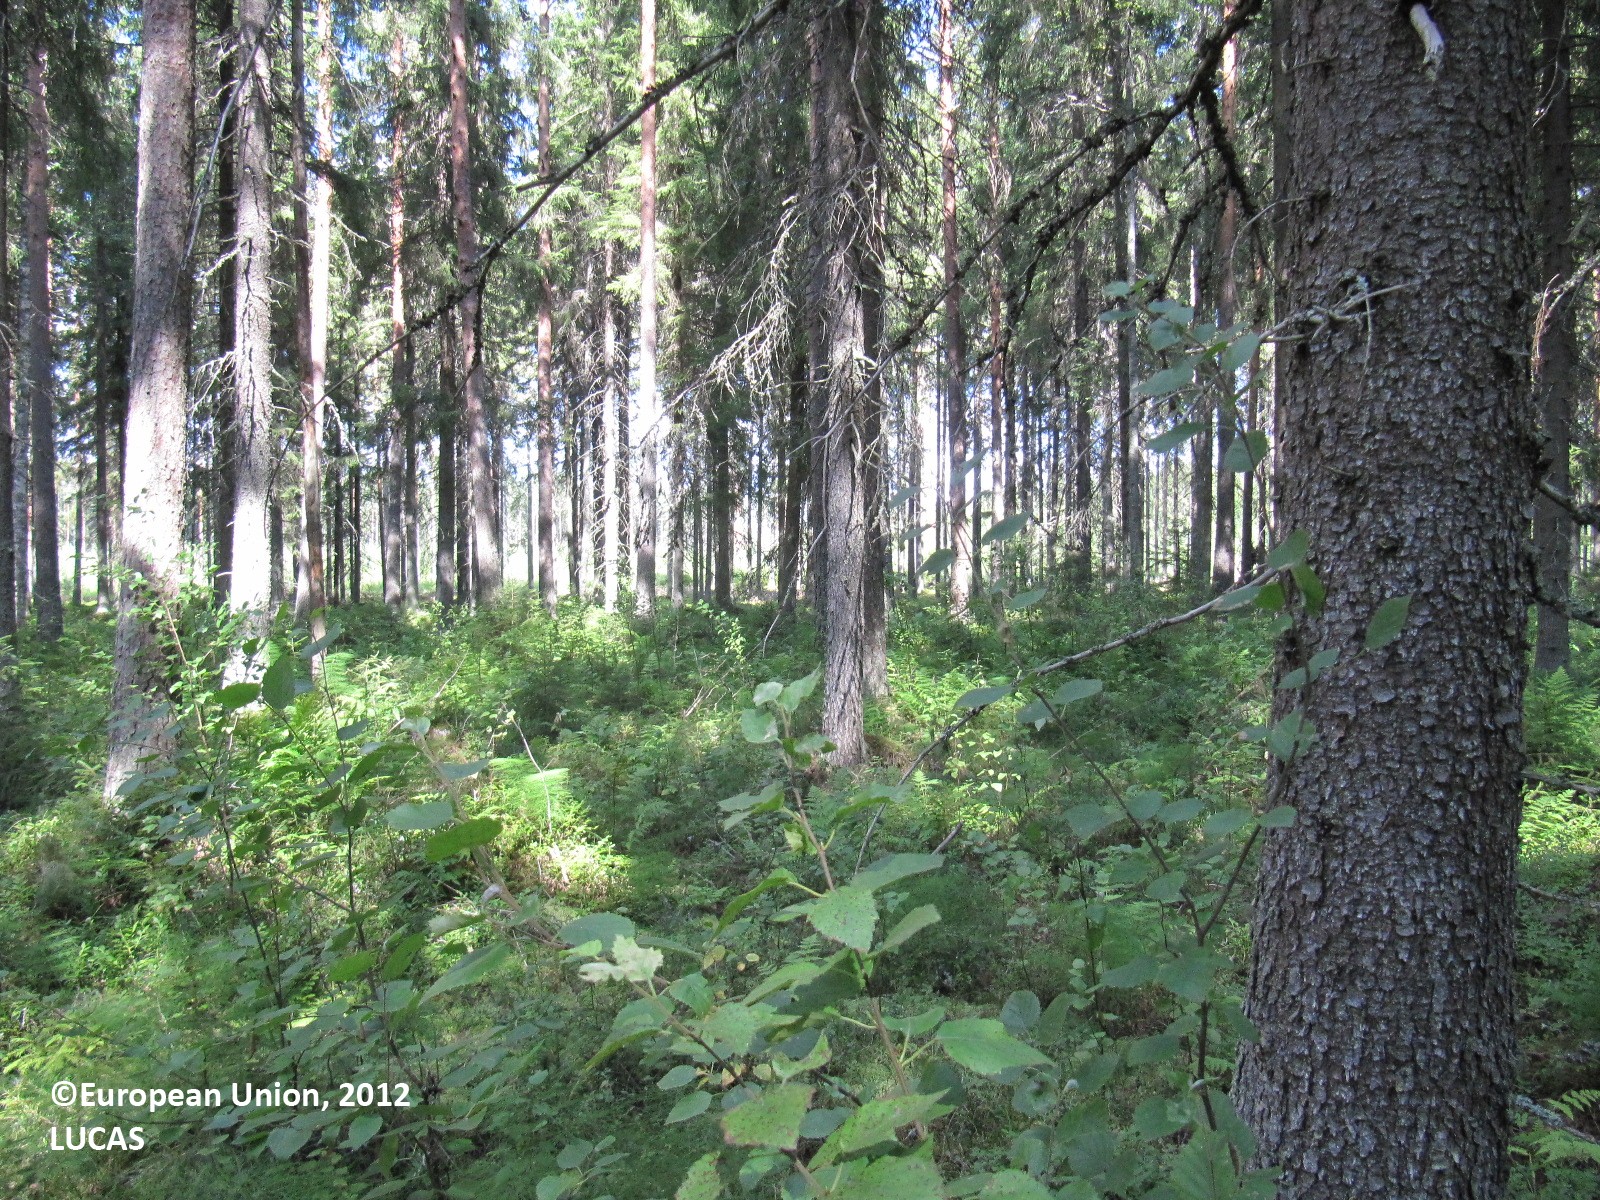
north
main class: Woodland
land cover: Spruce dominated coniferous woodland
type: boreal forest
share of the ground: > 75 %
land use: Forestry
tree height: > 5 m
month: August
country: FI
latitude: 60.7614
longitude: 24.3621
